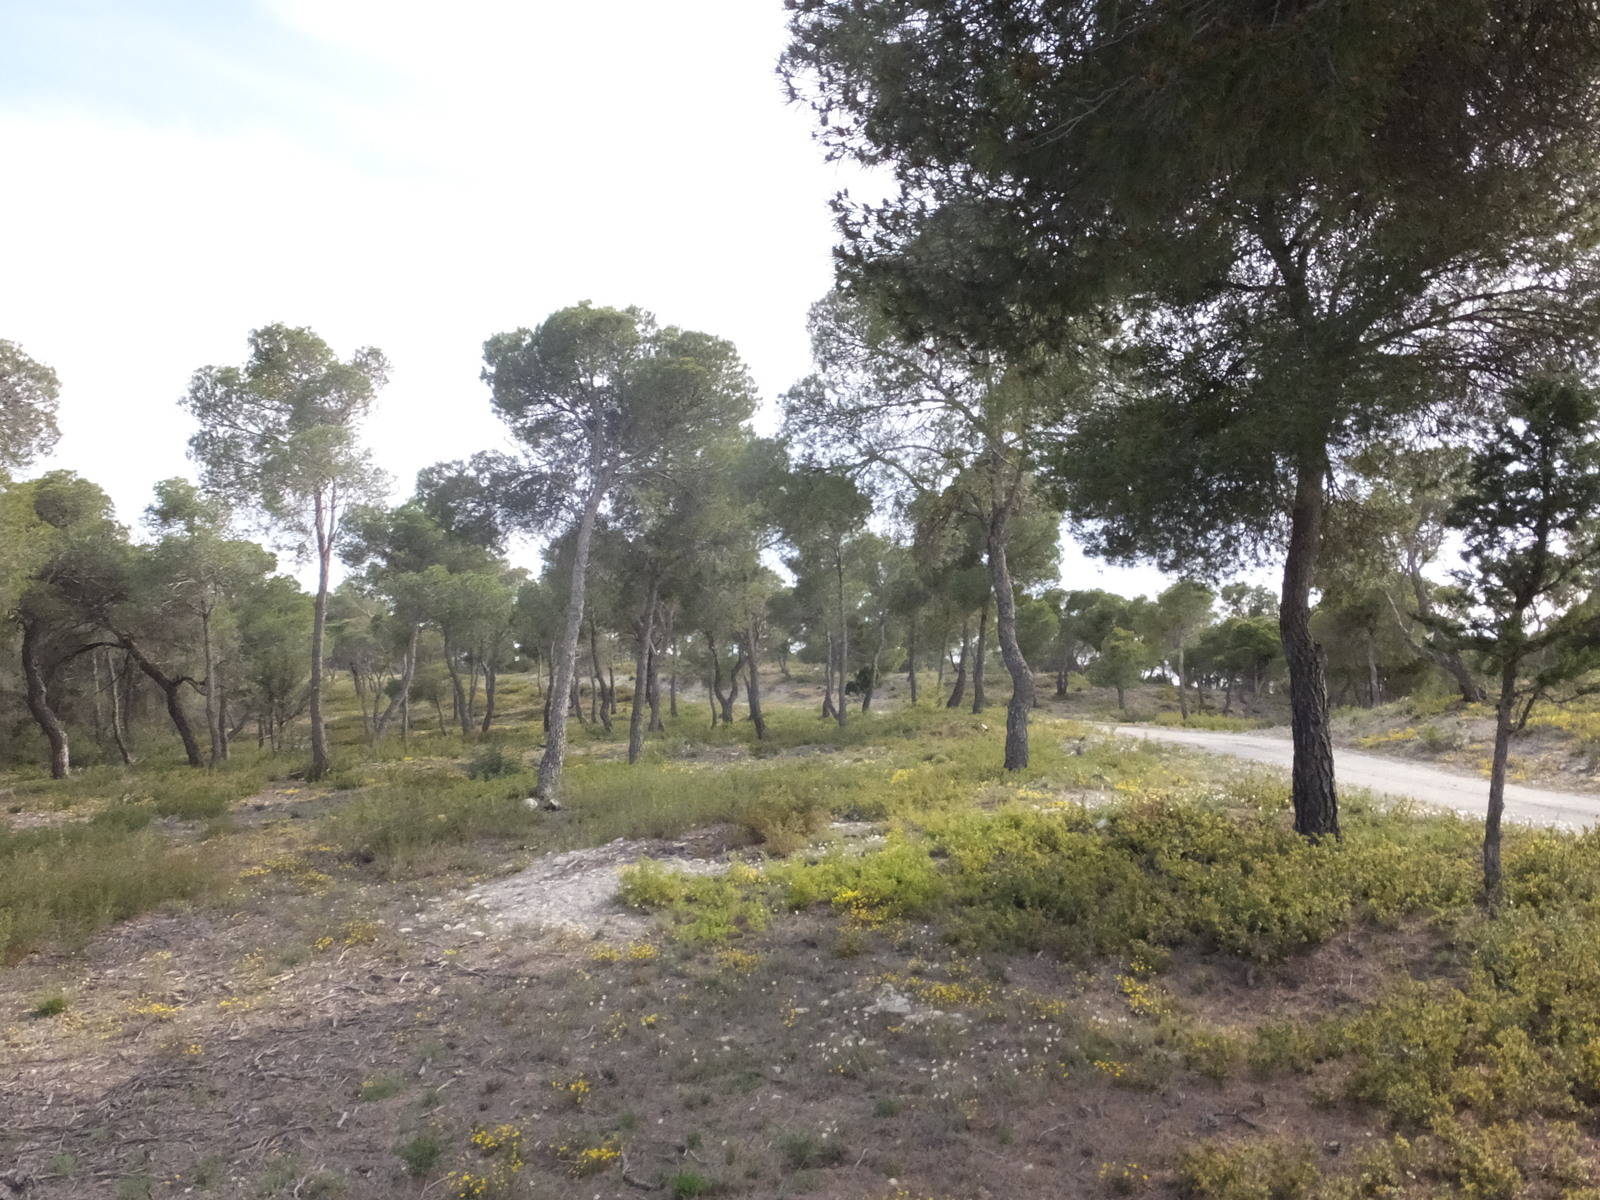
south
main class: Woodland
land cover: Pine dominated coniferous woodland
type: coniferous forest of the mediterranean region
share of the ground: 50 - 75 %
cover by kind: coniferous forest trees 70 %, broadleaved forest trees 15 %, shrubs 10 %, herbaceous plants 5 %
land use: Forestry
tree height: > 5 m
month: April
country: ES
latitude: 41.6153
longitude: -0.3262
